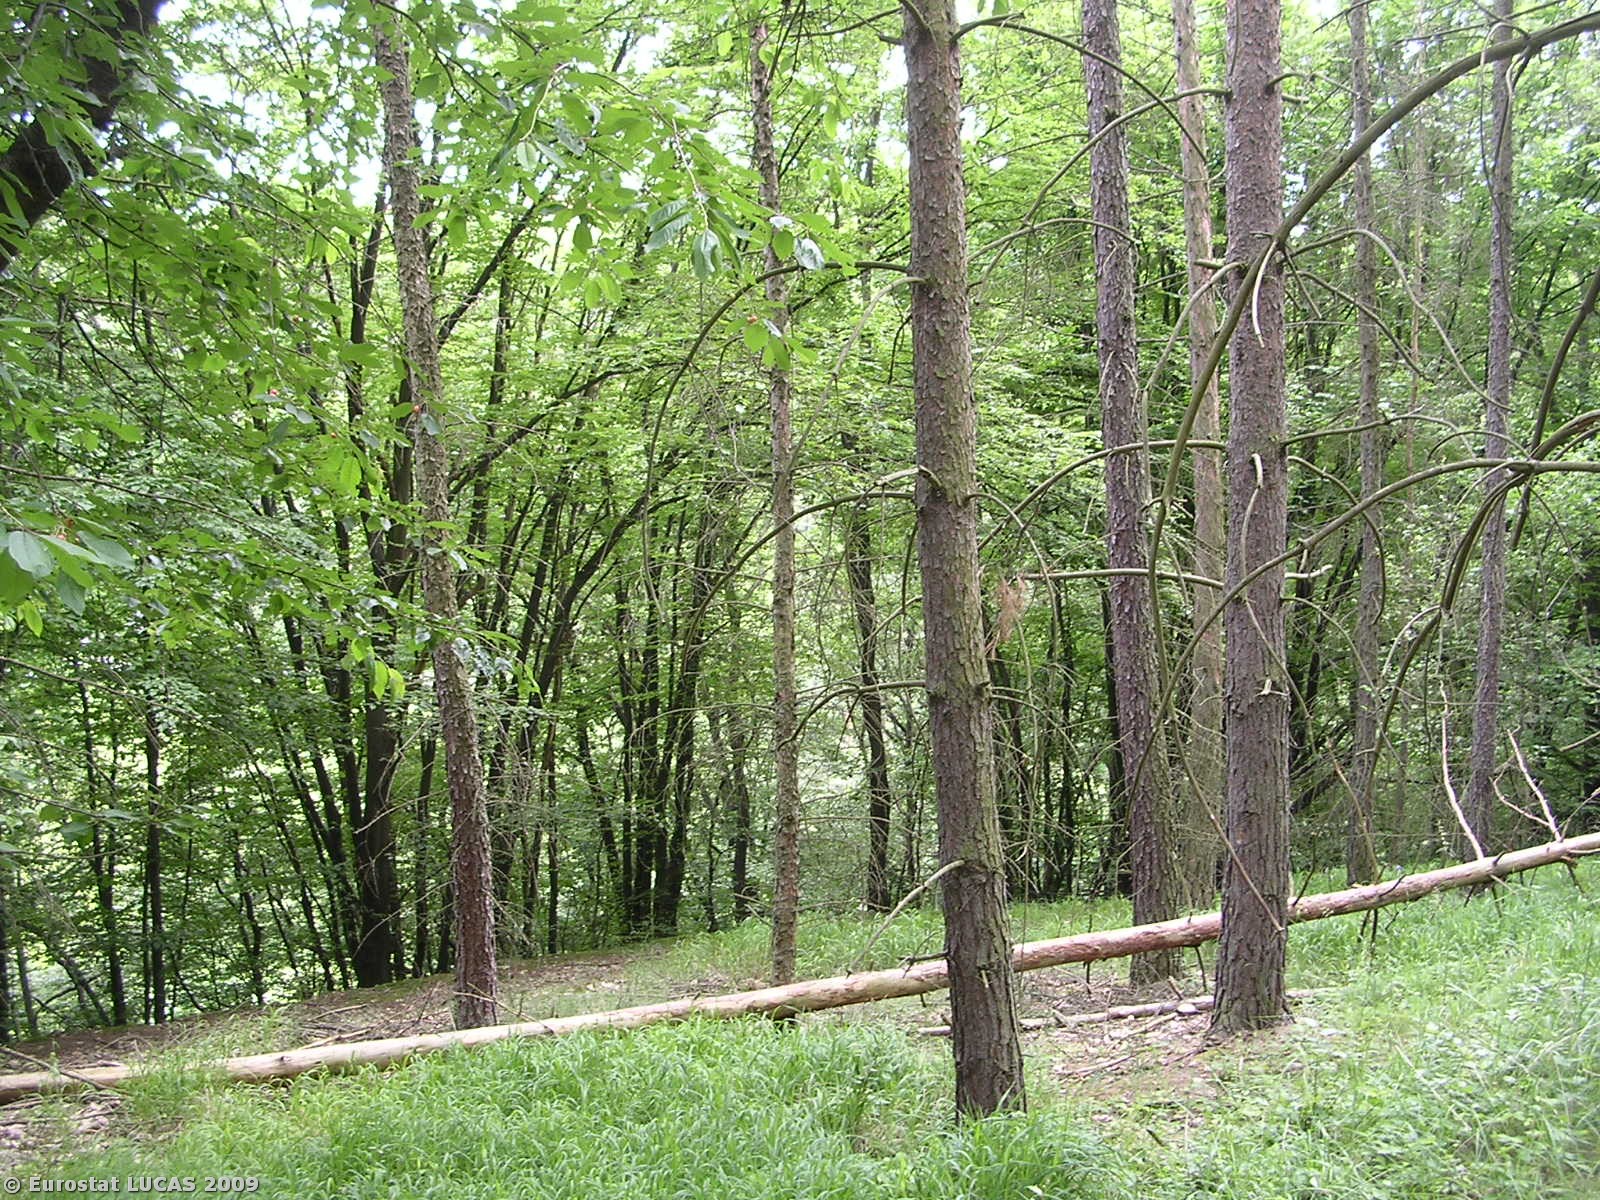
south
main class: Woodland
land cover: Coniferous woodland
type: hemiboreal forest and nemoral coniferous forest and mixed broadleaved-coniferous forest
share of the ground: > 75 %
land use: Forestry
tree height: > 5 m
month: June
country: CZ
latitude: 50.4727
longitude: 14.5248
